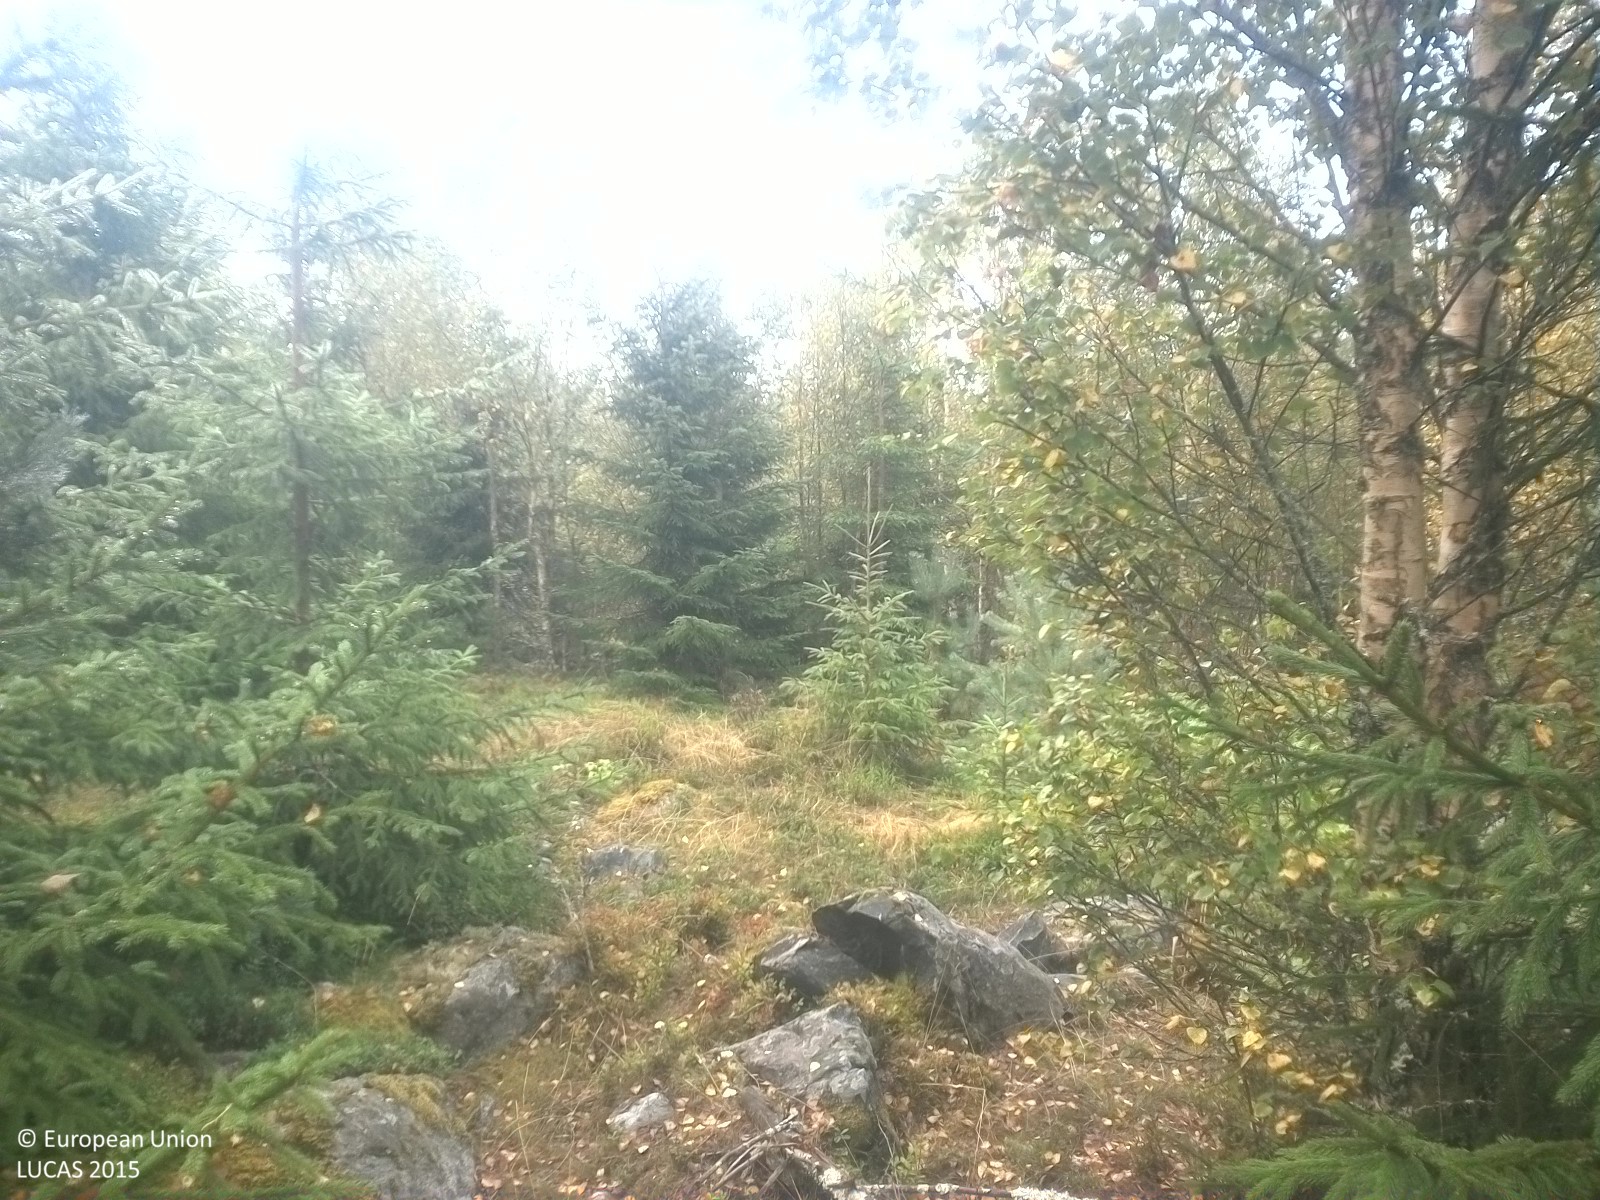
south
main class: Woodland
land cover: Other mixed woodland
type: boreal forest
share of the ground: 25 - 50 %
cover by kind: herbaceous plants 40 %, coniferous forest trees 25 %, lichens and mosses 20 %, broadleaved forest trees 15 %
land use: Forestry
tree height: < 5 m
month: September
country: SE
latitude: 59.3461
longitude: 15.6363
